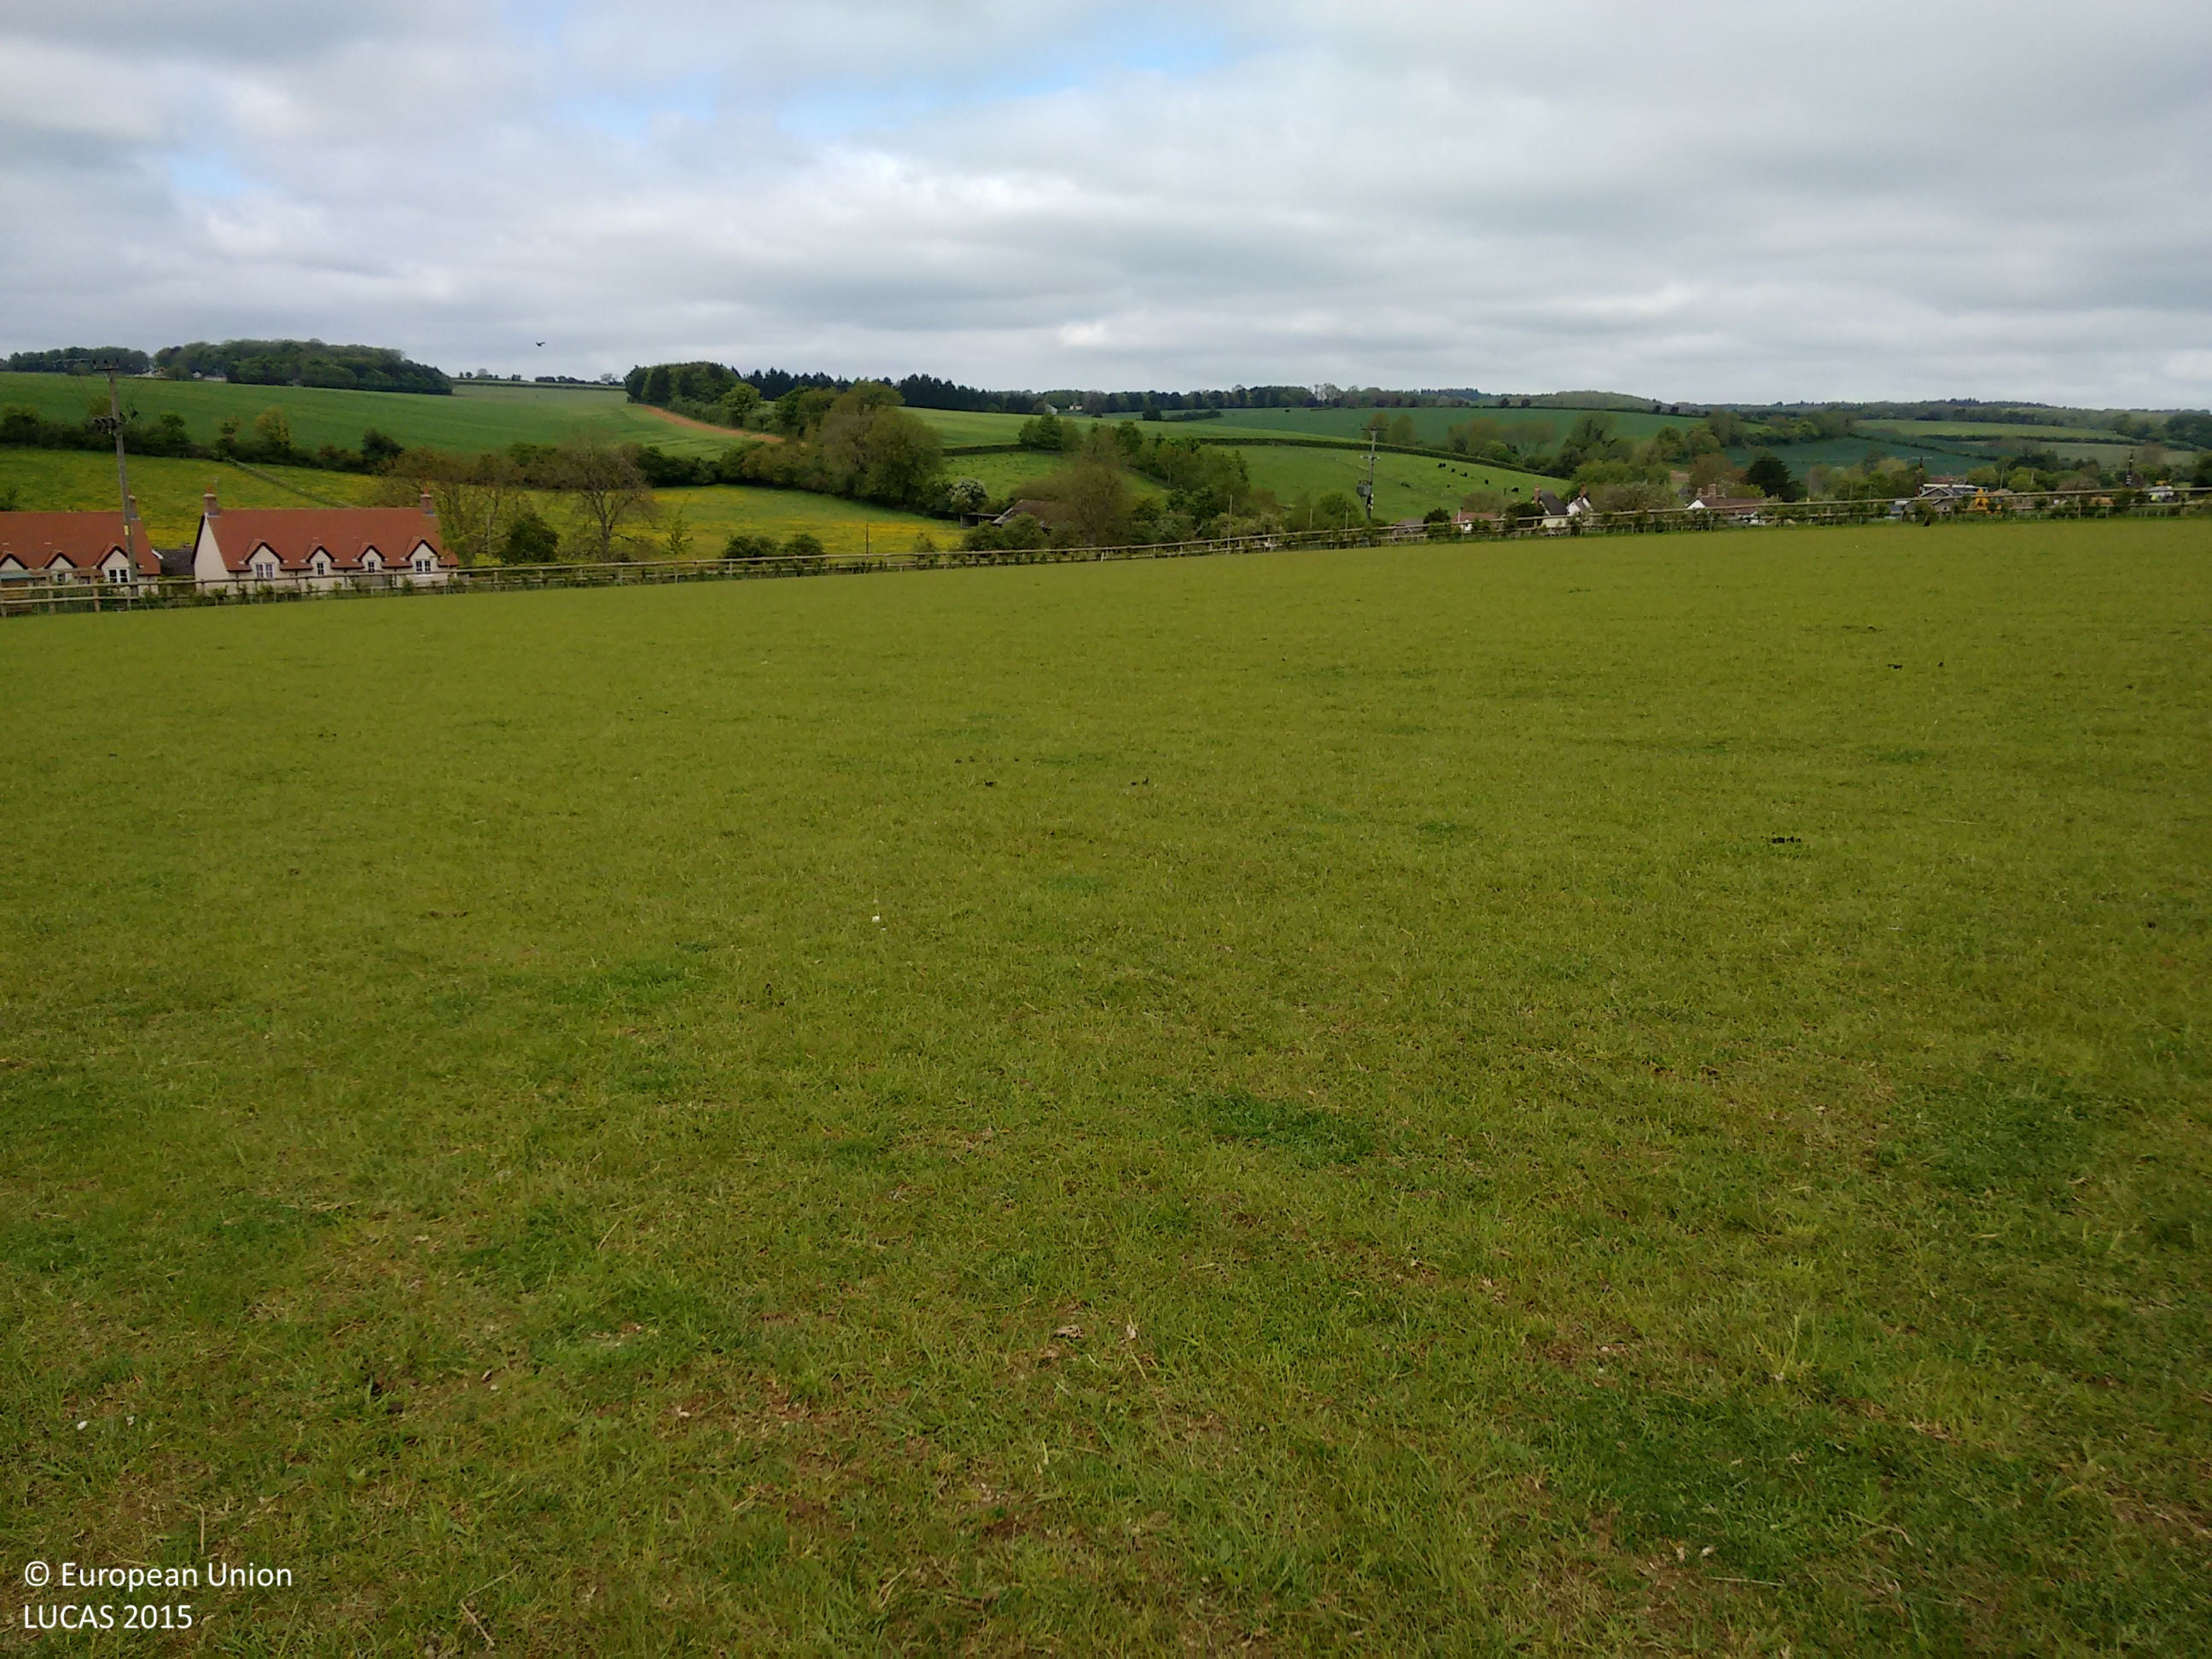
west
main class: Grassland
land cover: Grassland without tree/shrub cover
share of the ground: > 75 %
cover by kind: herbaceous plants 100 %
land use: Agriculture (excluding fallow land and kitchen gardens)
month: May
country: GB
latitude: 50.9183
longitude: -2.1082
